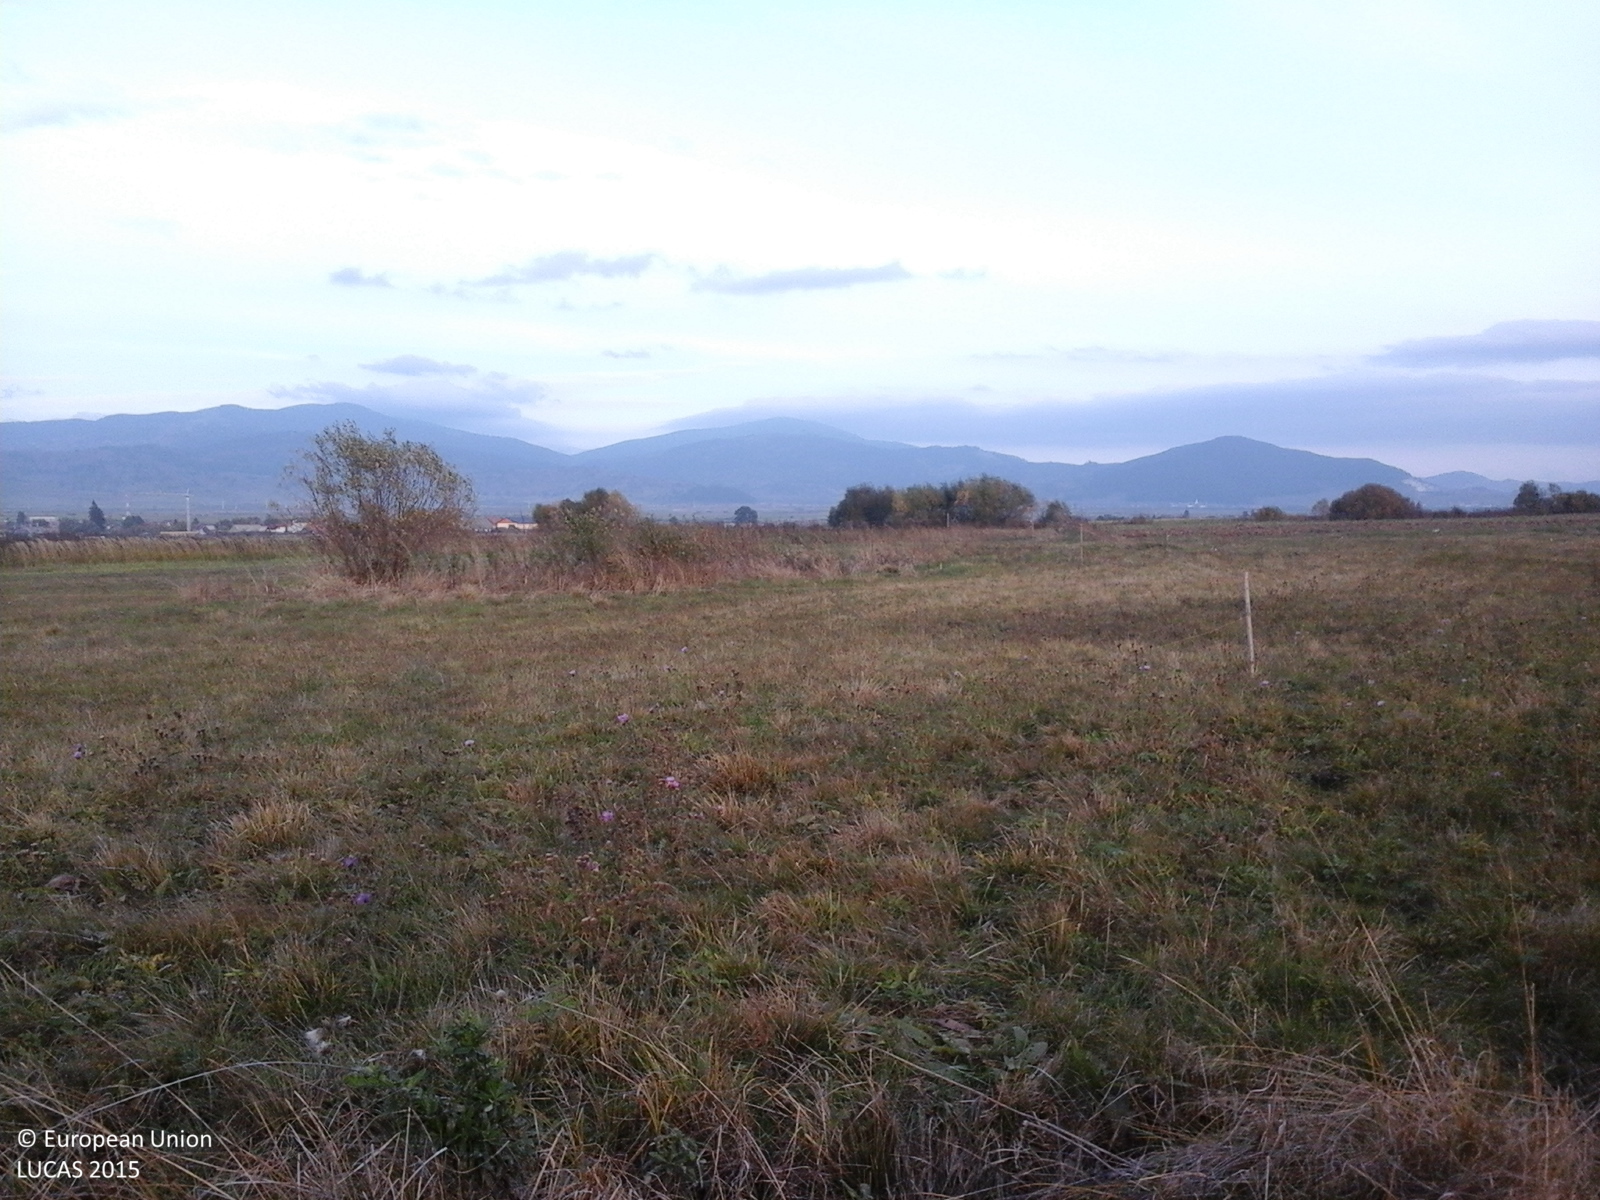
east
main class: Grassland
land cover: Grassland without tree/shrub cover
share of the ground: > 75 %
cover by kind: herbaceous plants 100 %
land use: Agriculture (excluding fallow land and kitchen gardens)
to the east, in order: Grassland without tree/shrub cover; Tracks; Grassland without tree/shrub cover; Abandoned hedges; Rivers and streams; Abandoned hedges; Rye
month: October
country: RO
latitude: 46.6541
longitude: 25.5434
